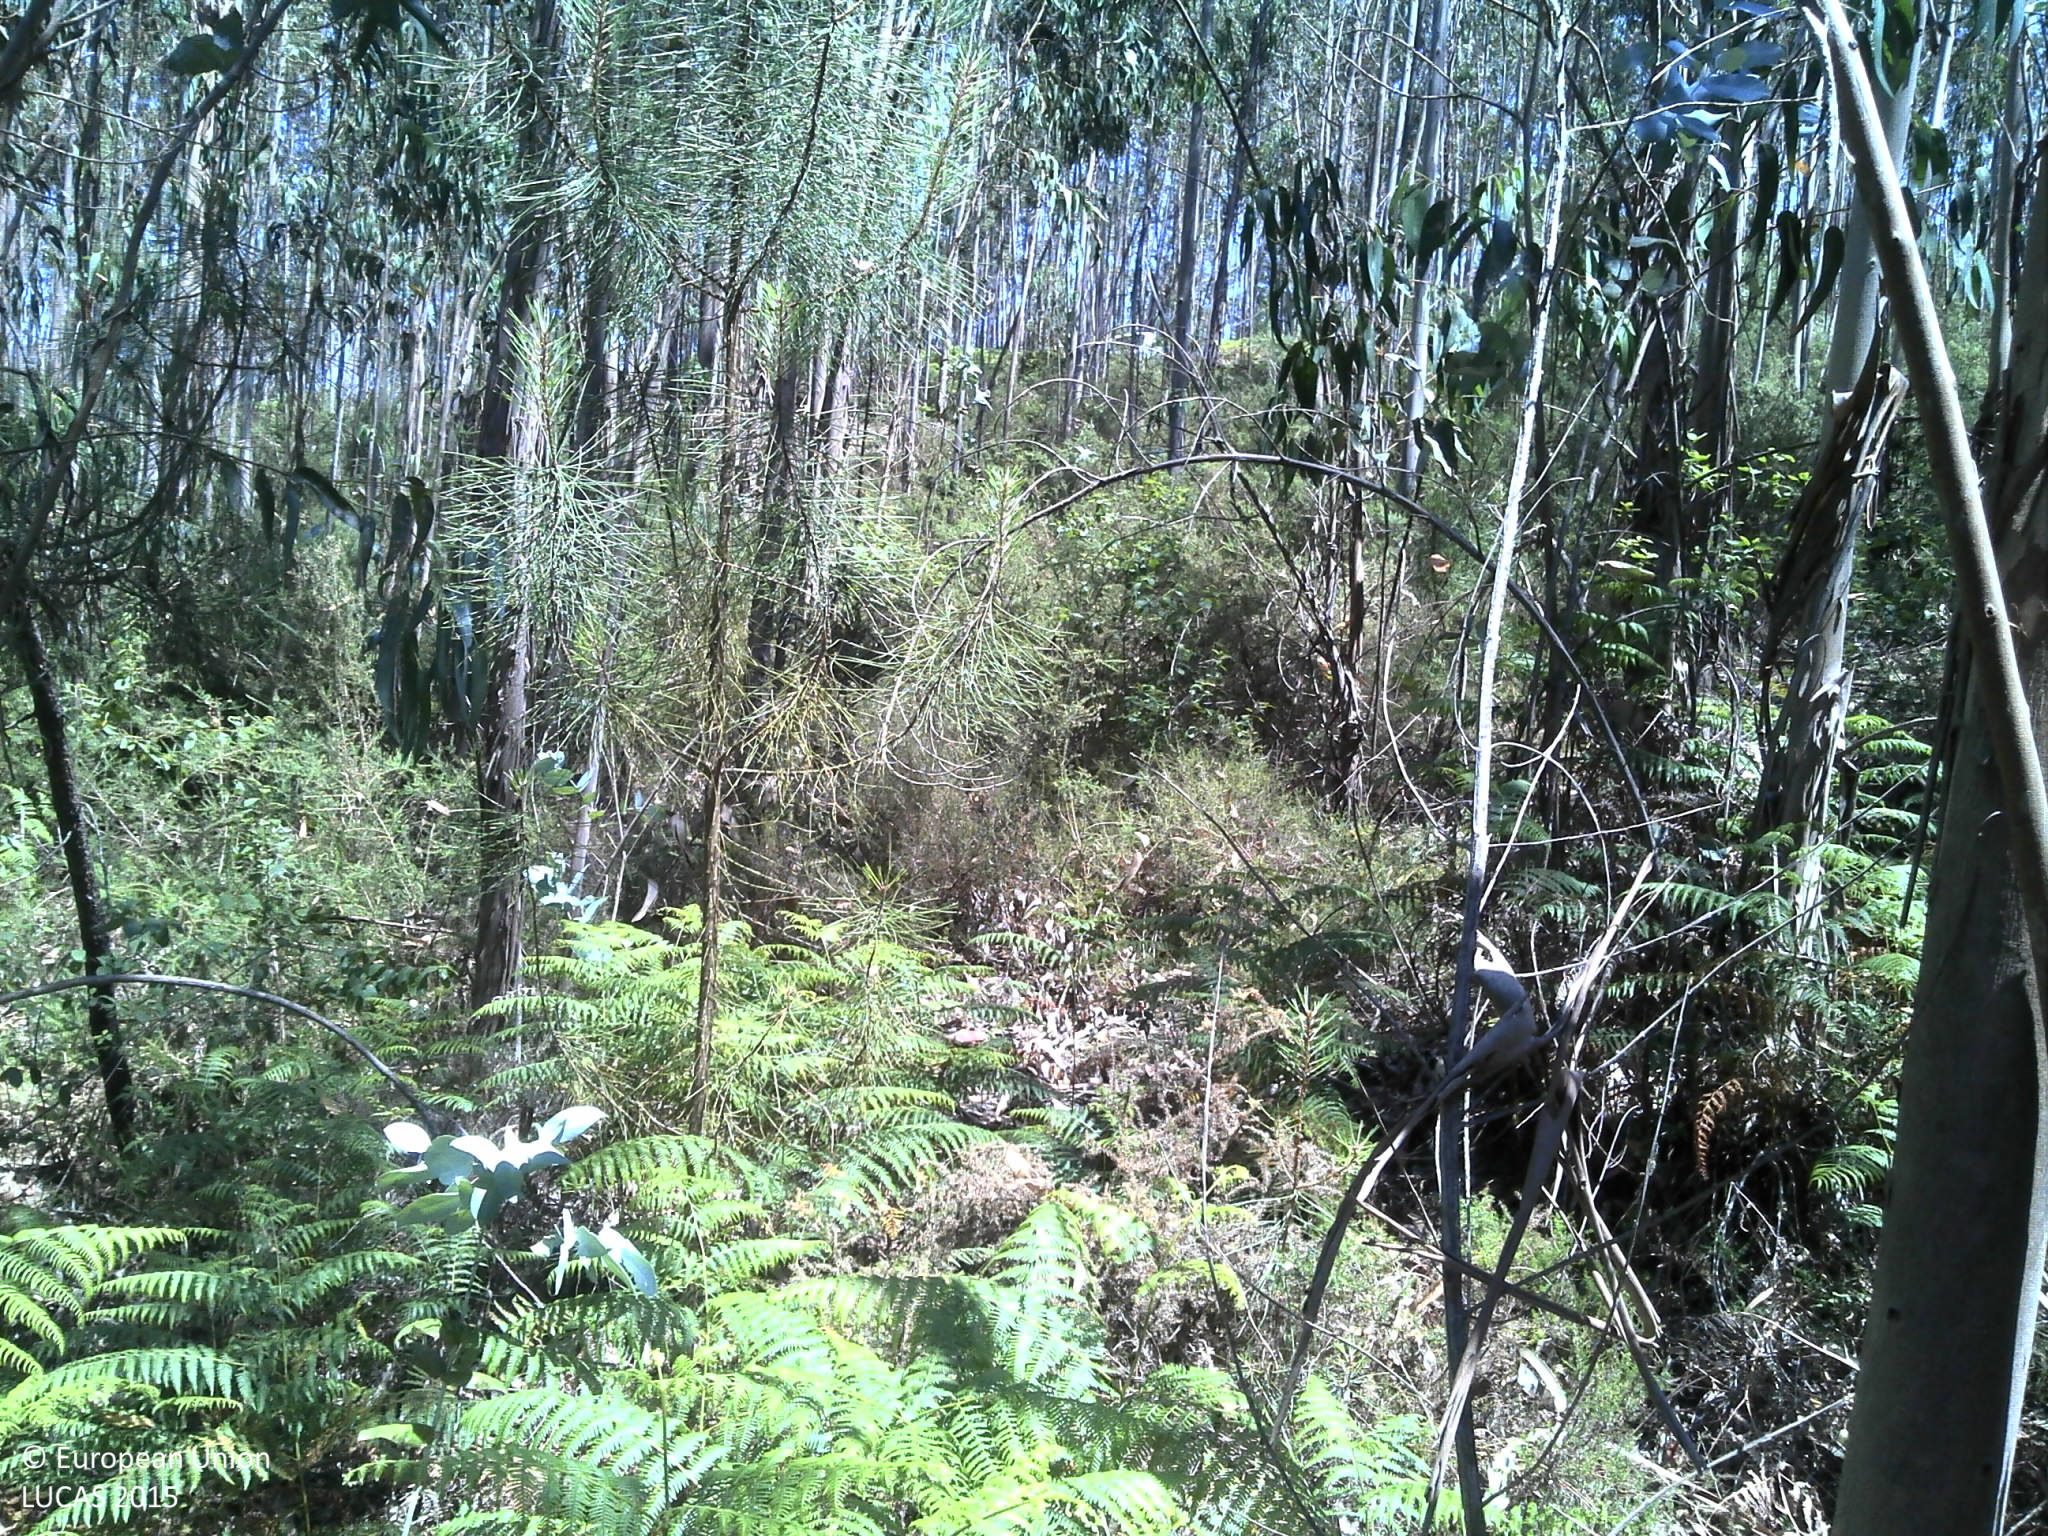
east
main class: Woodland
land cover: Broadleaved woodland
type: exotic forest
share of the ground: 50 - 75 %
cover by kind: broadleaved forest trees 55 %, shrubs 30 %, herbaceous plants 10 %, unconsolidated bare surface 5 %
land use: Forestry
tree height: > 5 m
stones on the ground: < 10 %
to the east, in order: Broadleaved woodland; Tracks; Broadleaved woodland; Tracks; Broadleaved woodland; Tracks; Broadleaved woodland
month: June
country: PT
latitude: 40.7495
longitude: -8.3904
